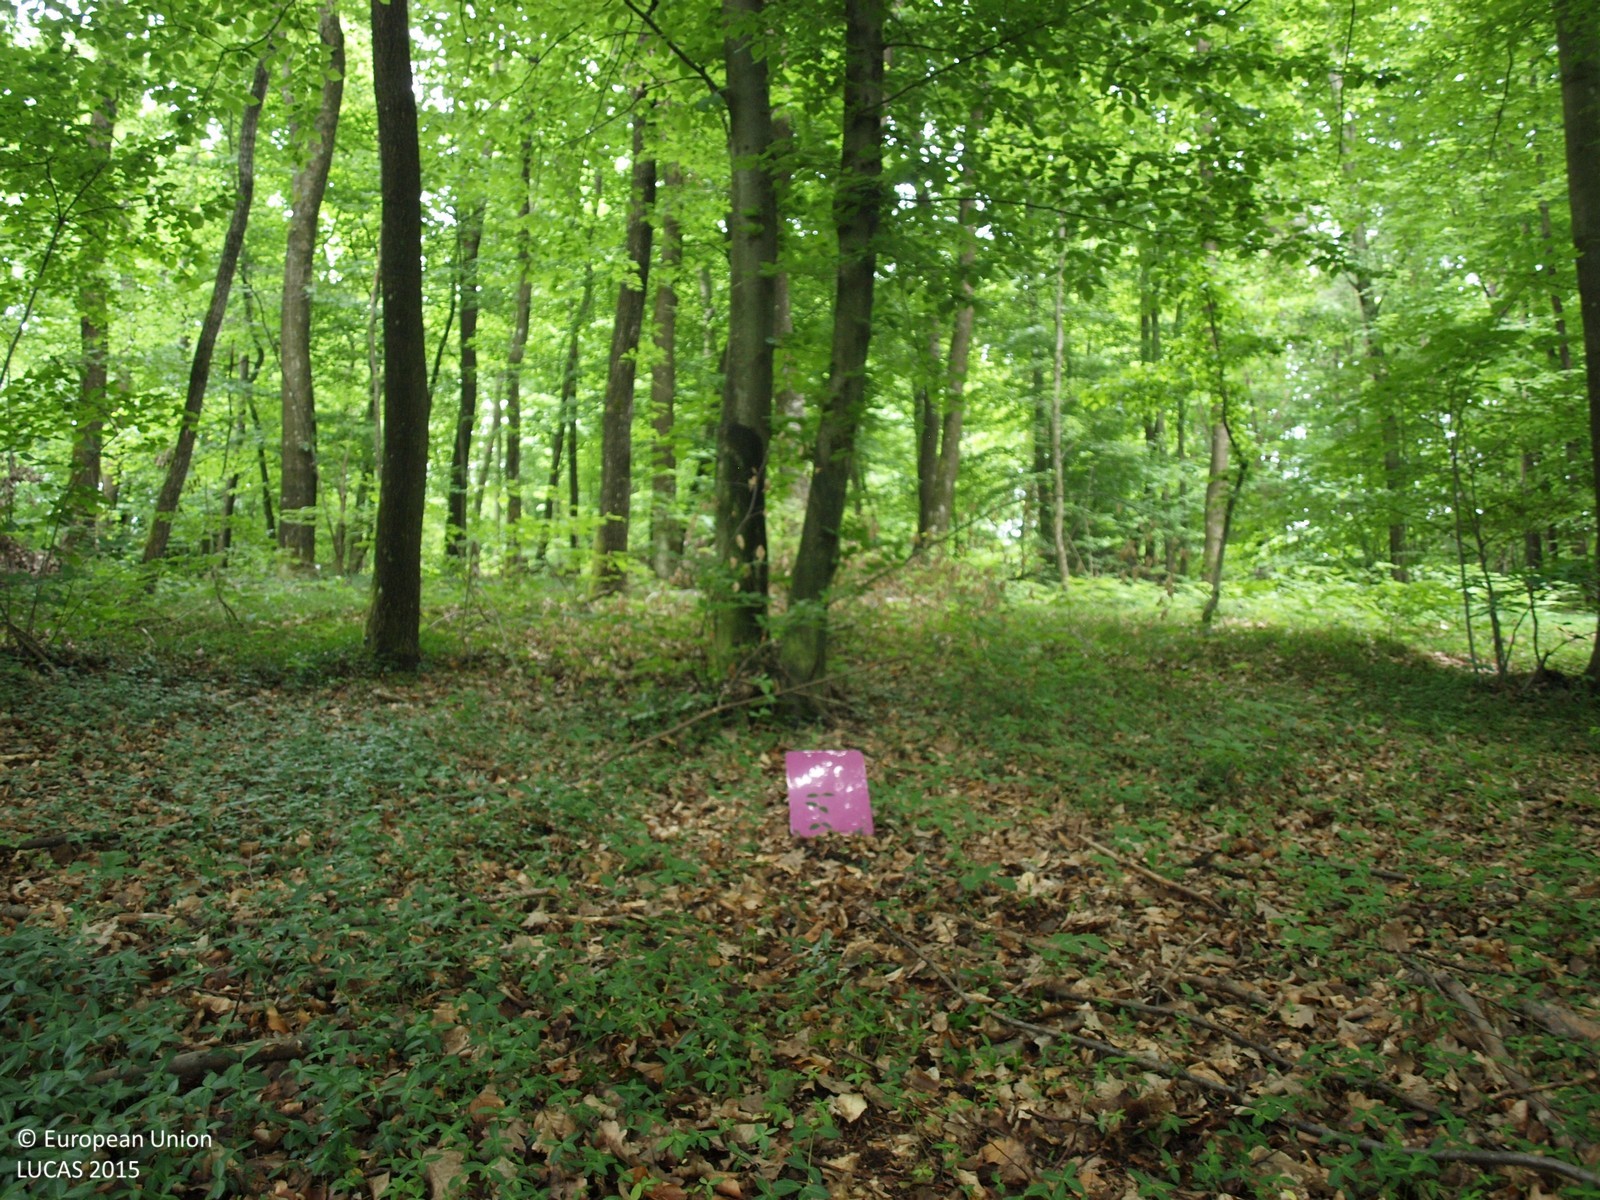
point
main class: Woodland
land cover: Broadleaved woodland
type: mesophytic deciduous forest
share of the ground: > 75 %
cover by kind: broadleaved forest trees 90 %, shrubs 5 %, herbaceous plants 5 %
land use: Forestry
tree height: > 5 m
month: May
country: HR
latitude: 46.1218
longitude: 16.1201
